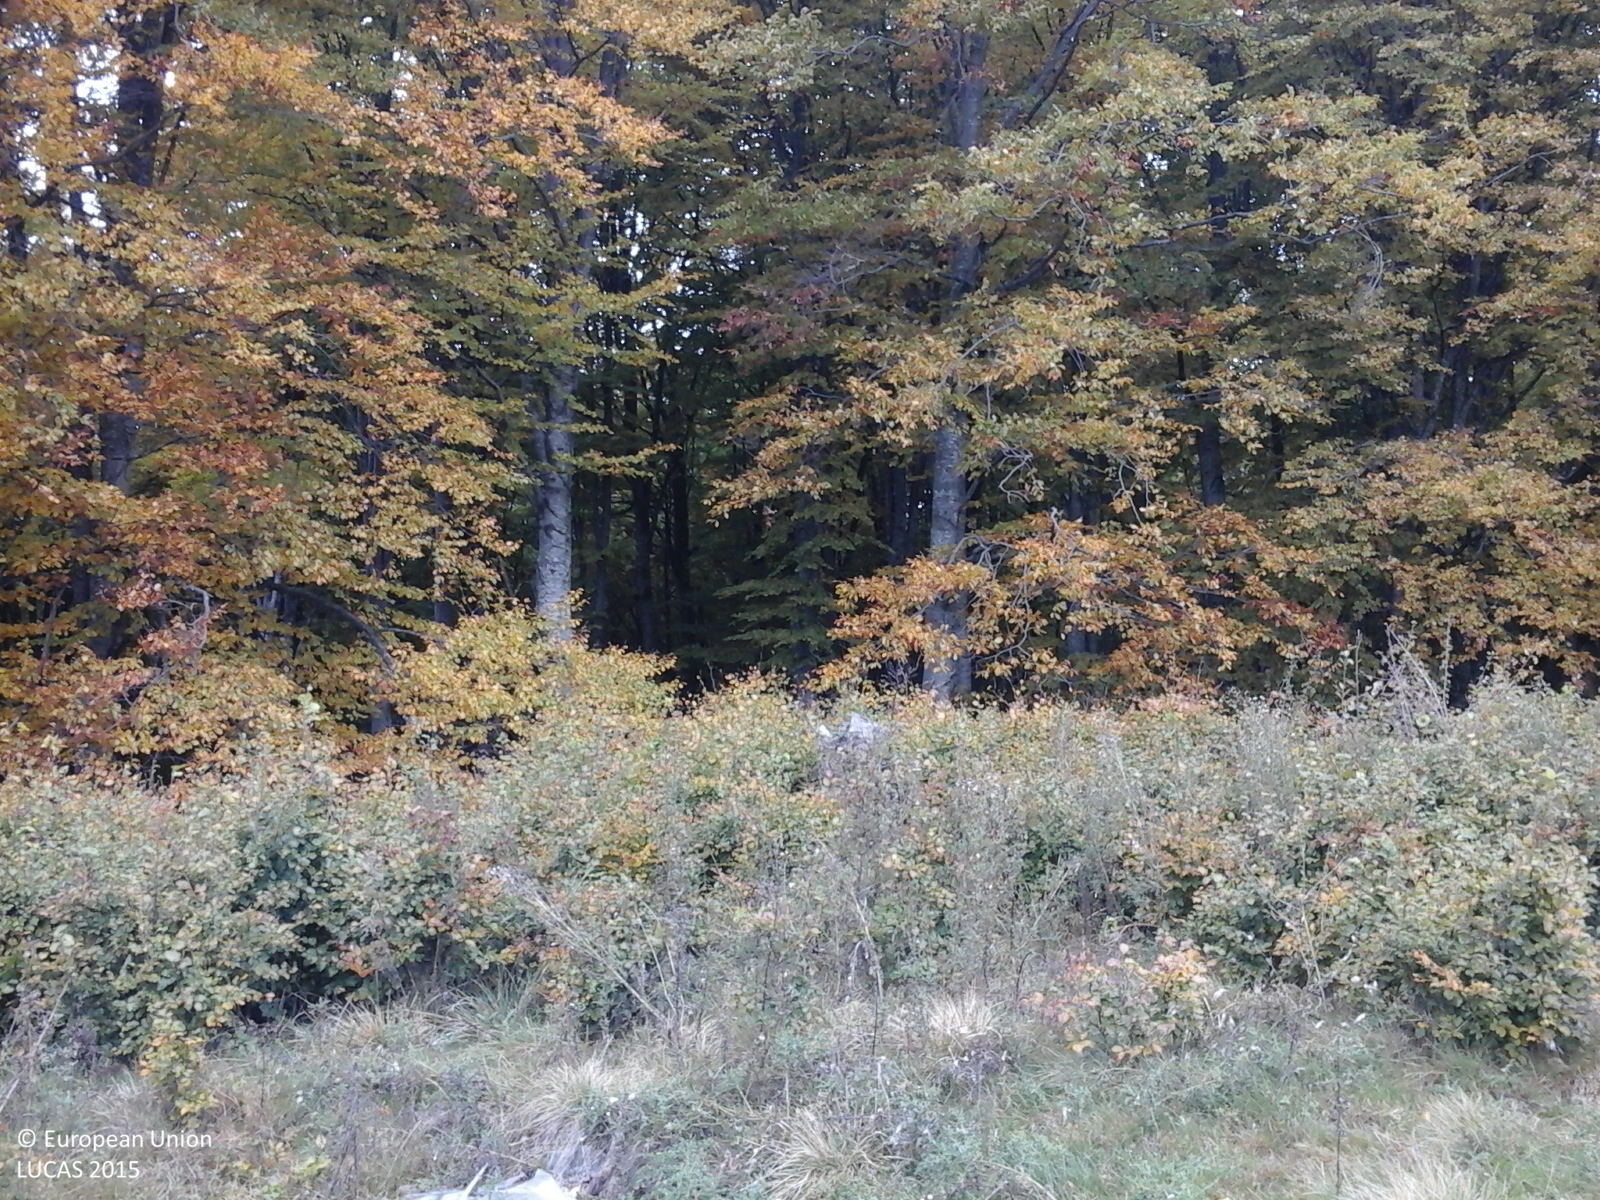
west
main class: Grassland
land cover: Grassland without tree/shrub cover
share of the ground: > 75 %
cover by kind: herbaceous plants 100 %
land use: Agriculture (excluding fallow land and kitchen gardens)
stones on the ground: < 10 %
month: October
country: RO
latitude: 46.6084
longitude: 24.9685
